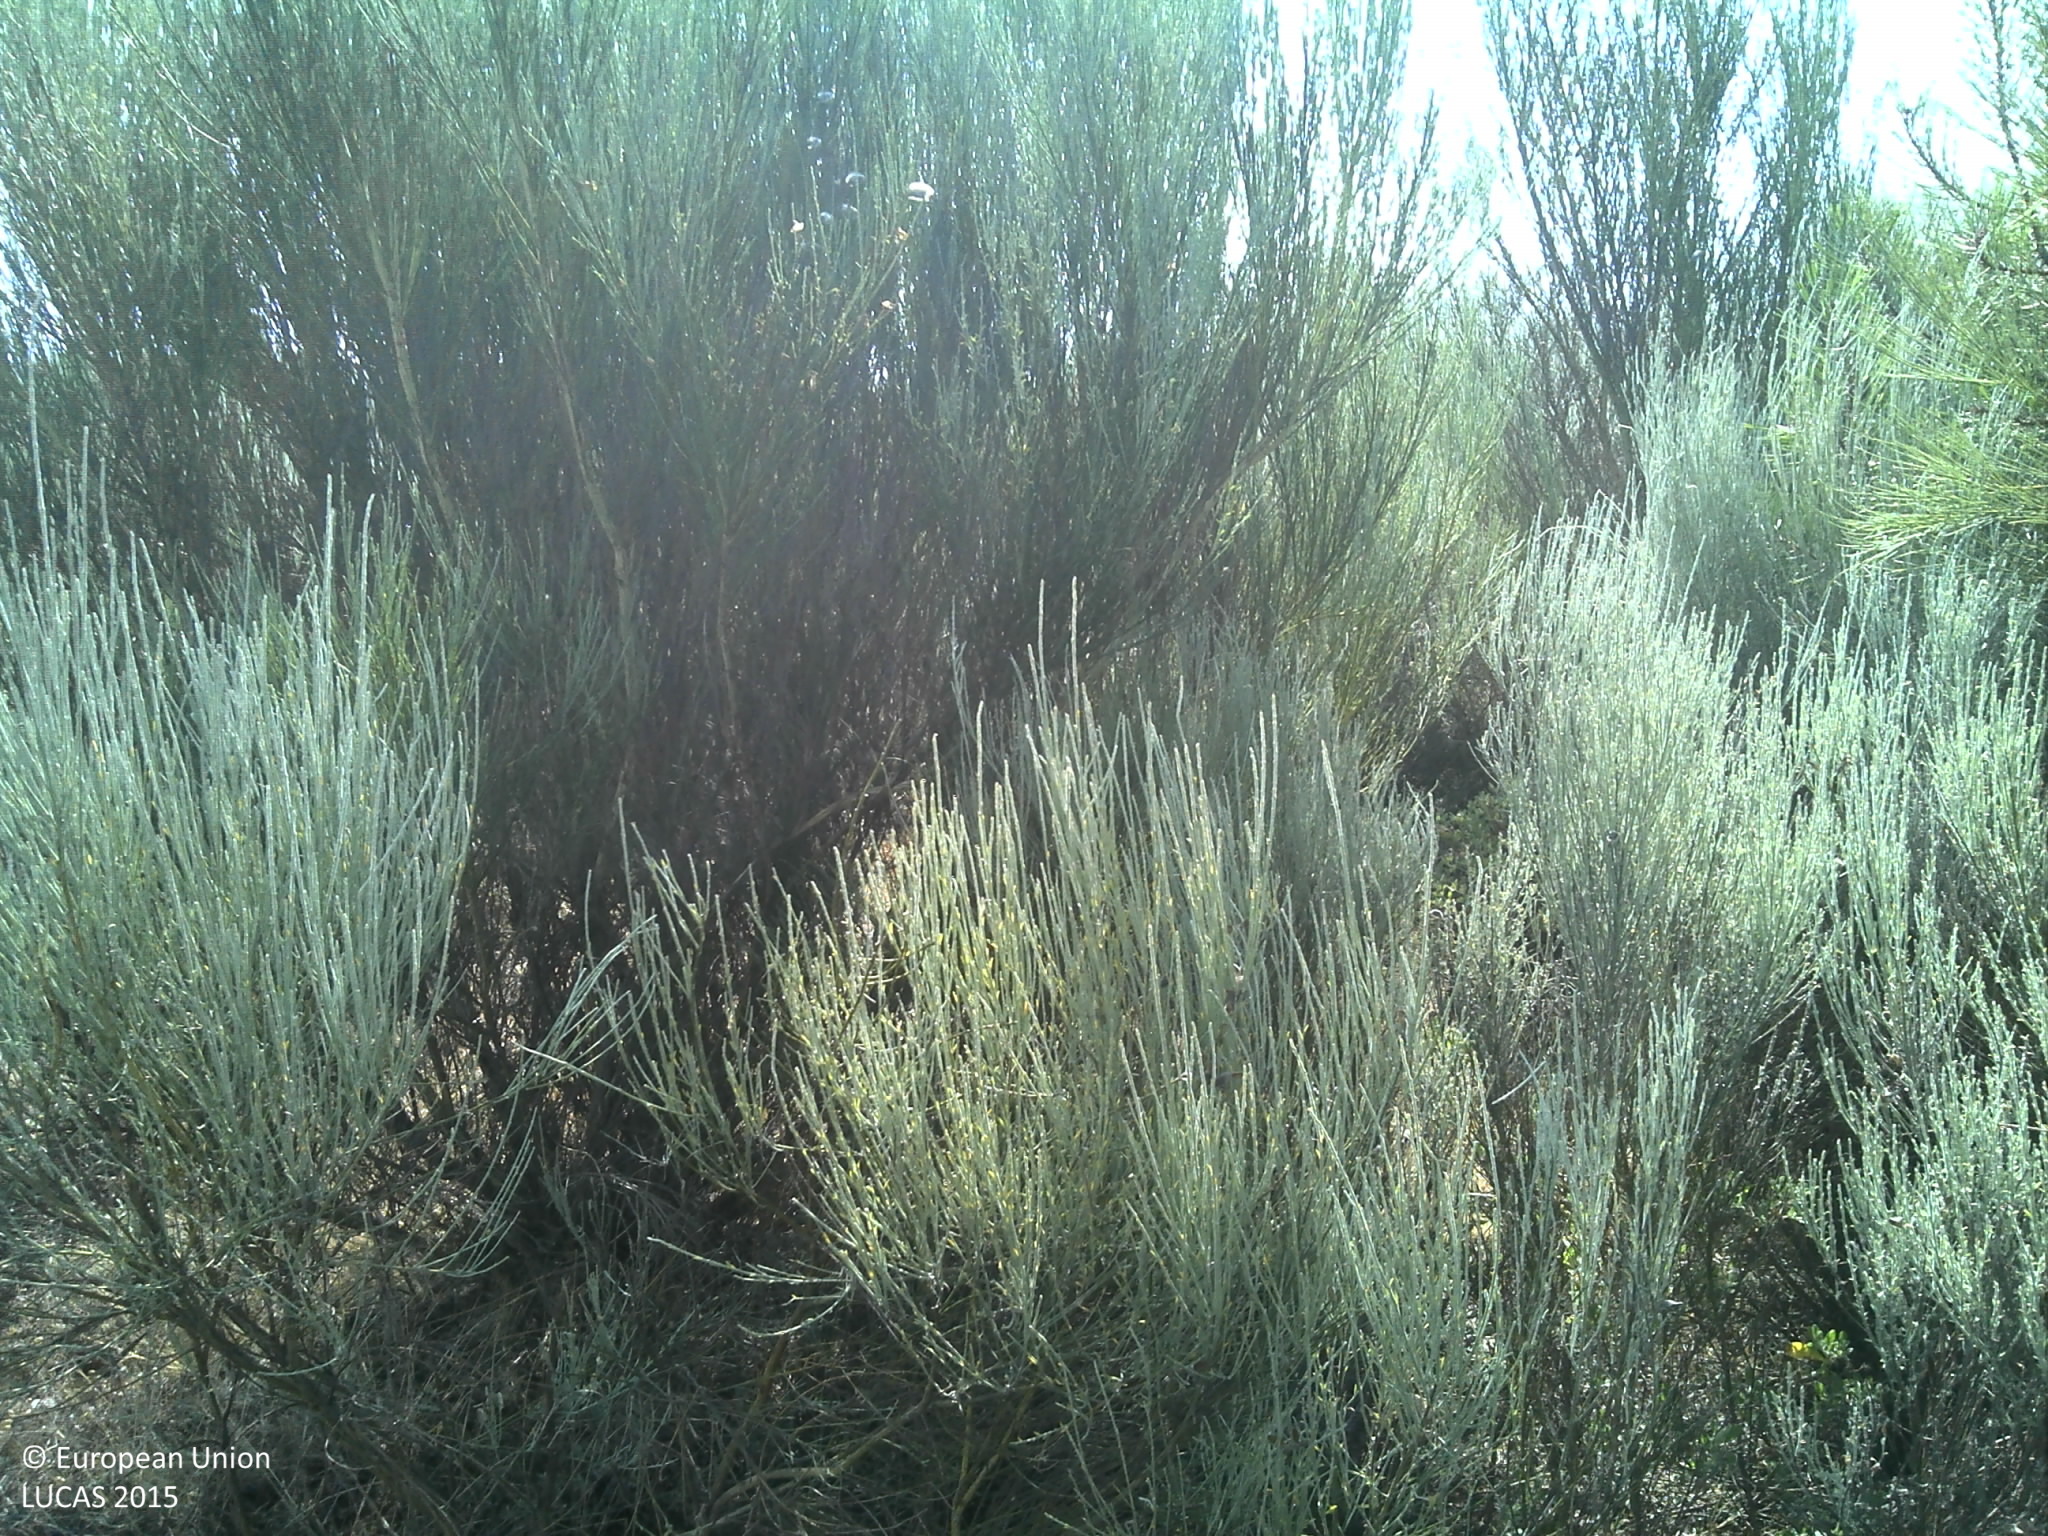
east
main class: Shrubland
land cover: Shrubland with sparse tree cover
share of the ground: 50 - 75 %
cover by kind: shrubs 60 %, herbaceous plants 25 %, coniferous forest trees 5 %, consolidated bare surface 5 %, unconsolidated bare surface 5 %
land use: Semi-natural and natural areas not in use
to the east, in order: Shrubland with sparse tree cover; Tracks; Shrubland without tree cover; Rocks and stones; Shruby margins; Tracks; Shrubland without tree cover; Rocks and stones; Shrubland without tree cover; Rocks and stones; Shrubland without tree cover
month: July
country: PT
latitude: 40.8228
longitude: -7.3889
